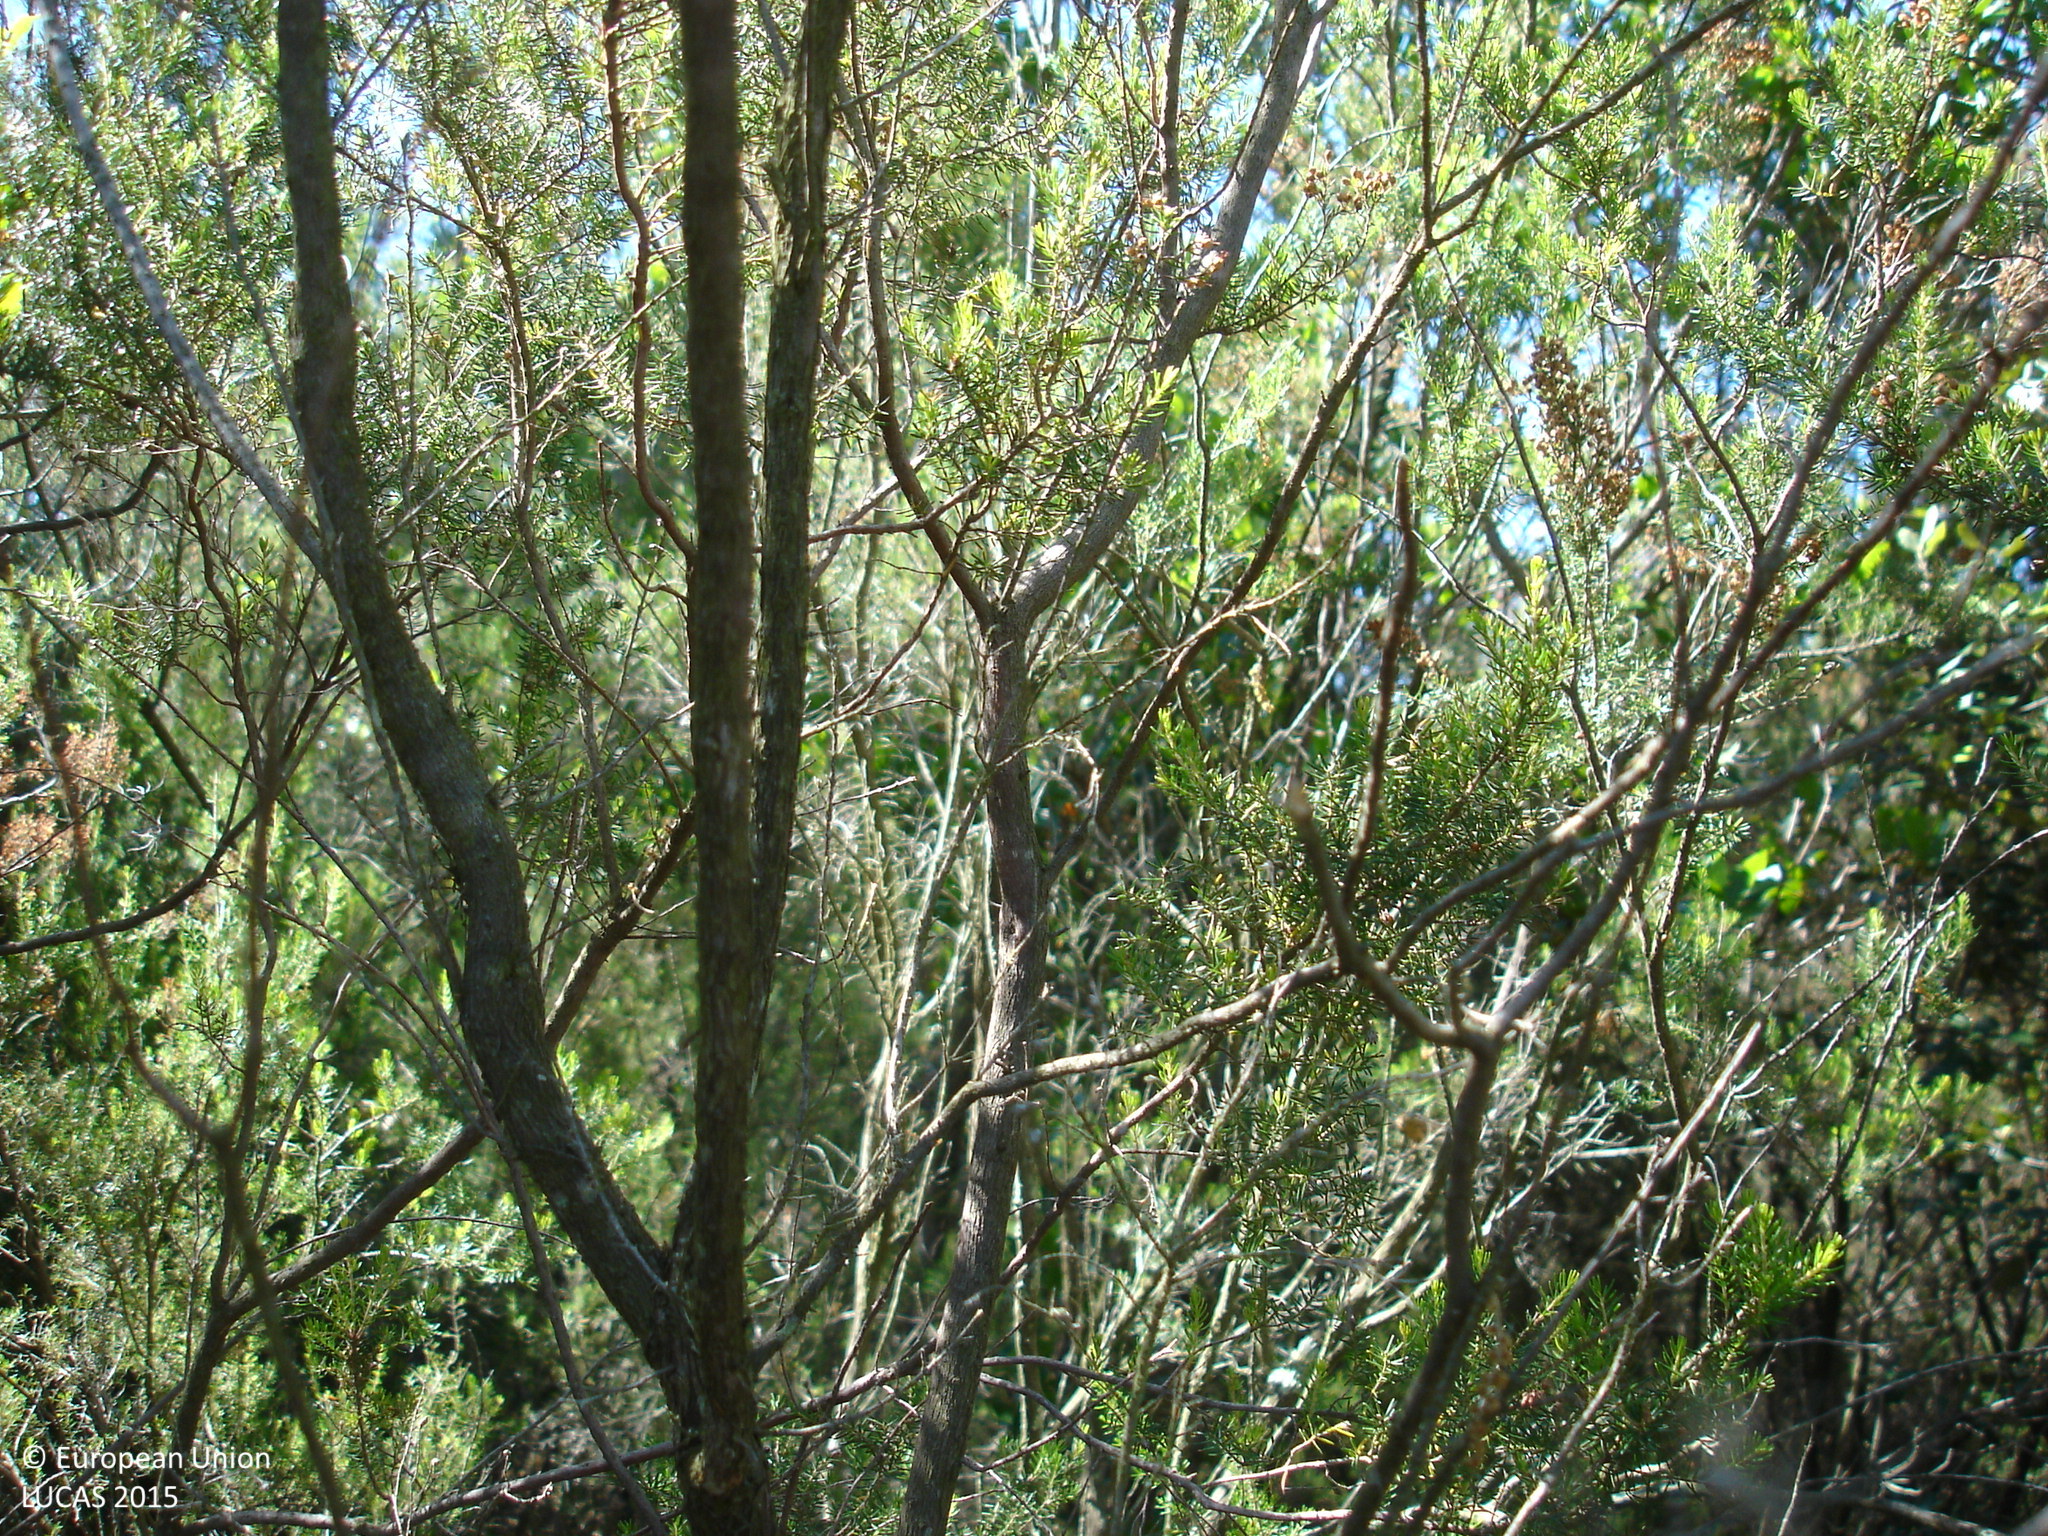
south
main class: Woodland
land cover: Broadleaved woodland
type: thermophilous deciduous forest
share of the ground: > 75 %
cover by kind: broadleaved forest trees 75 %, herbaceous plants 25 %
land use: Forestry
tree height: > 5 m
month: June
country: ES
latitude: 41.7662
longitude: 2.5947
